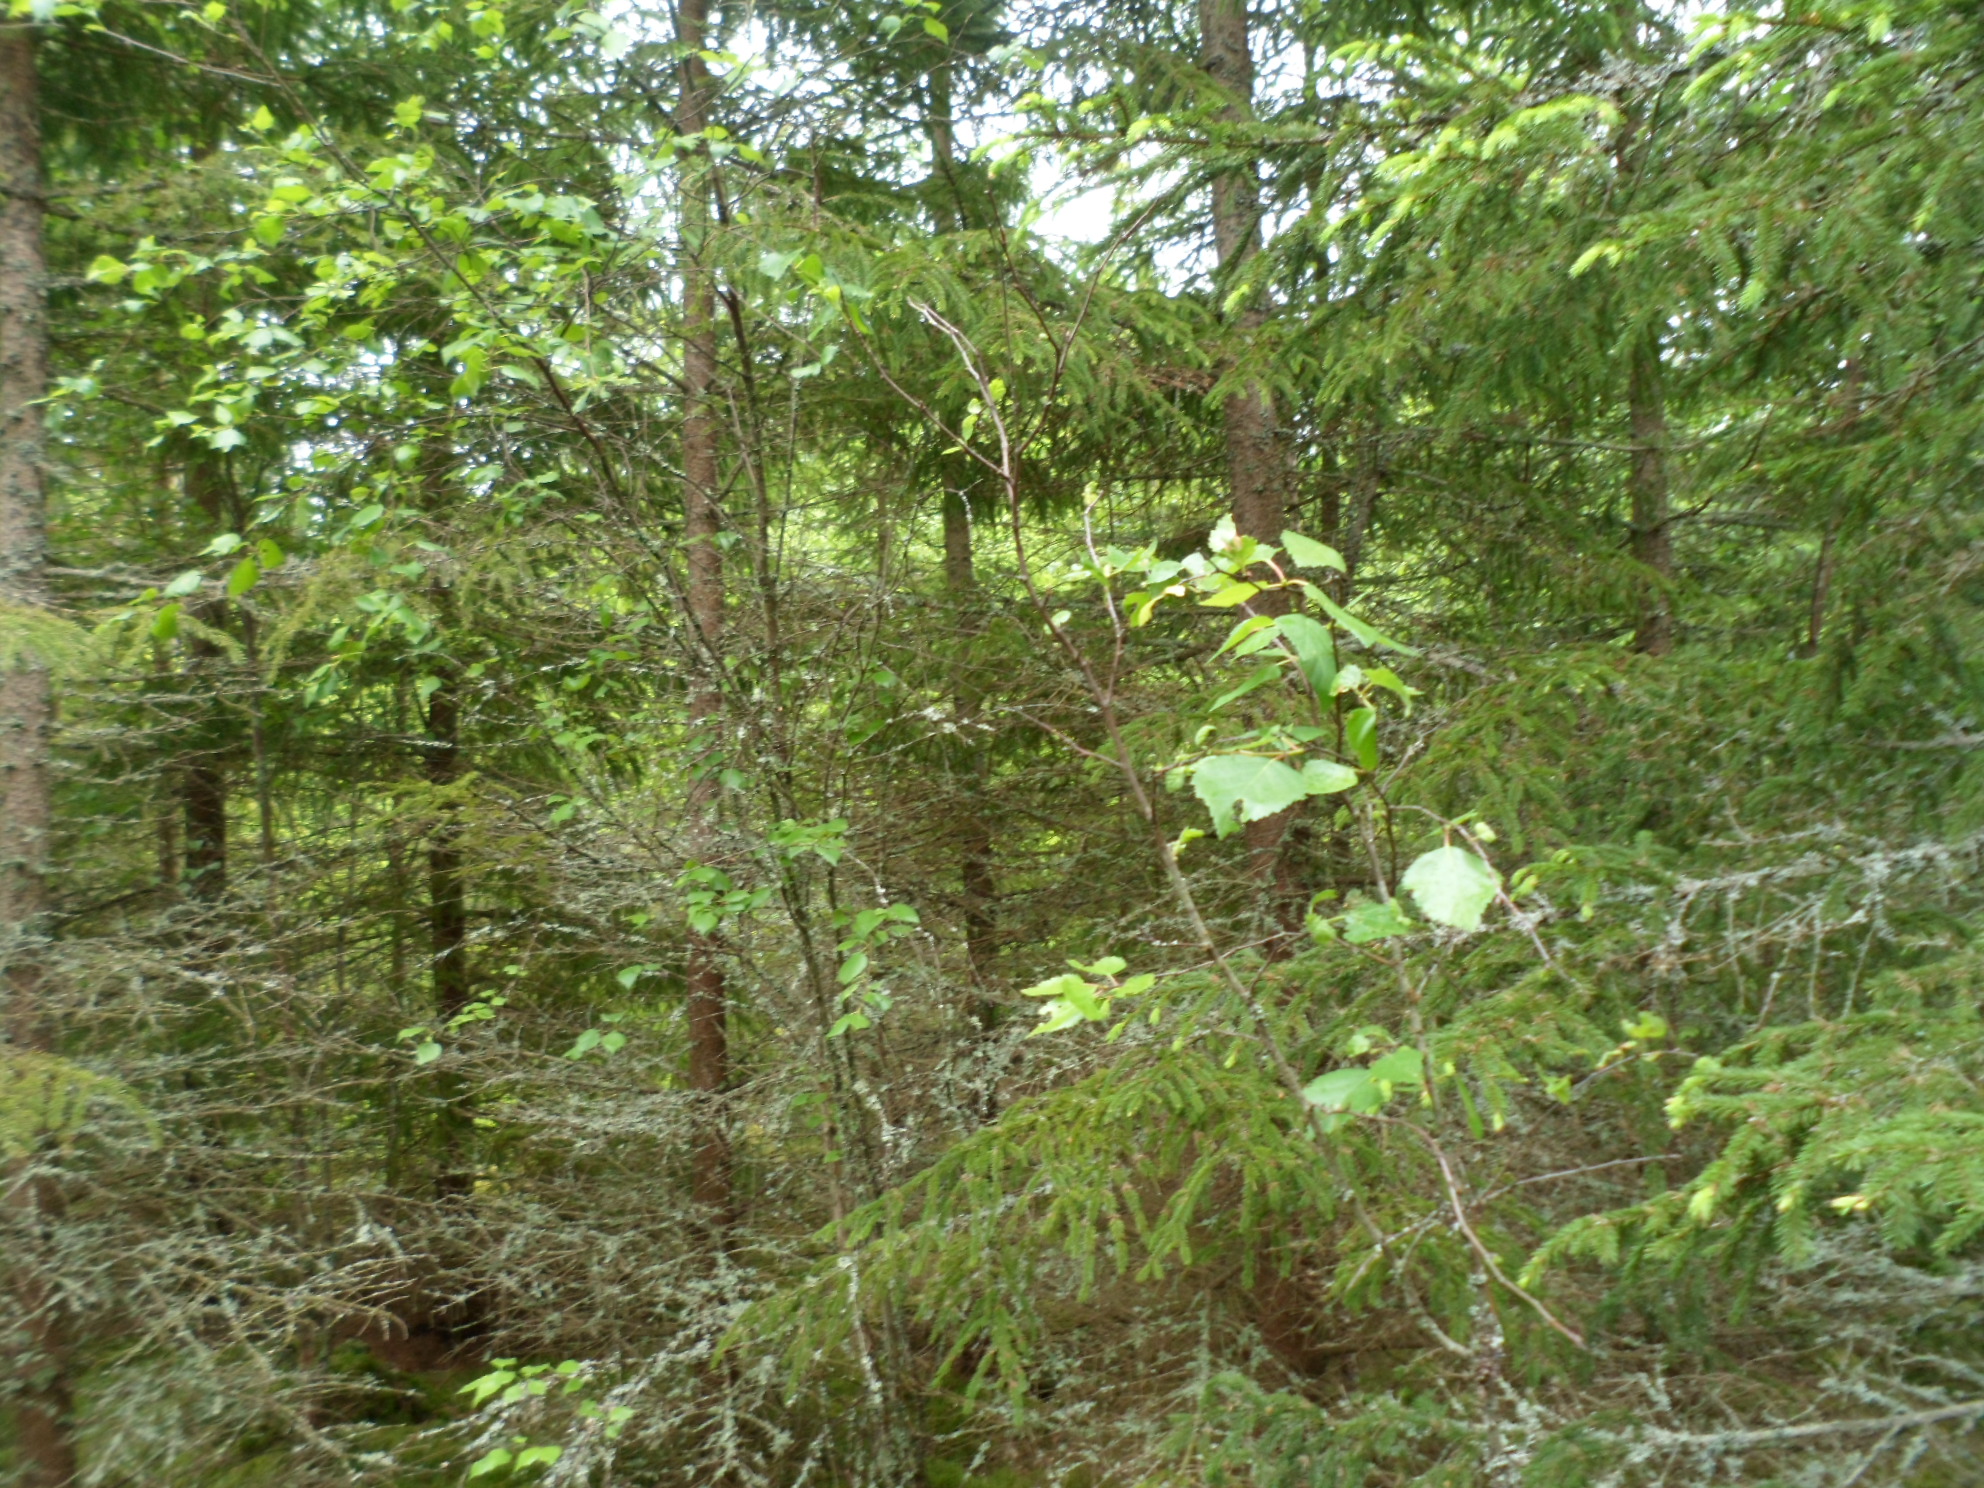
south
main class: Woodland
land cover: Spruce dominated coniferous woodland
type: boreal forest
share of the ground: > 75 %
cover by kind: coniferous forest trees 75 %, shrubs 10 %, lichens and mosses 10 %, herbaceous plants 5 %
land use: Forestry
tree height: > 5 m
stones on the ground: 25 - 50 %
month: June
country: SE
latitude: 57.0878
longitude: 15.2944
